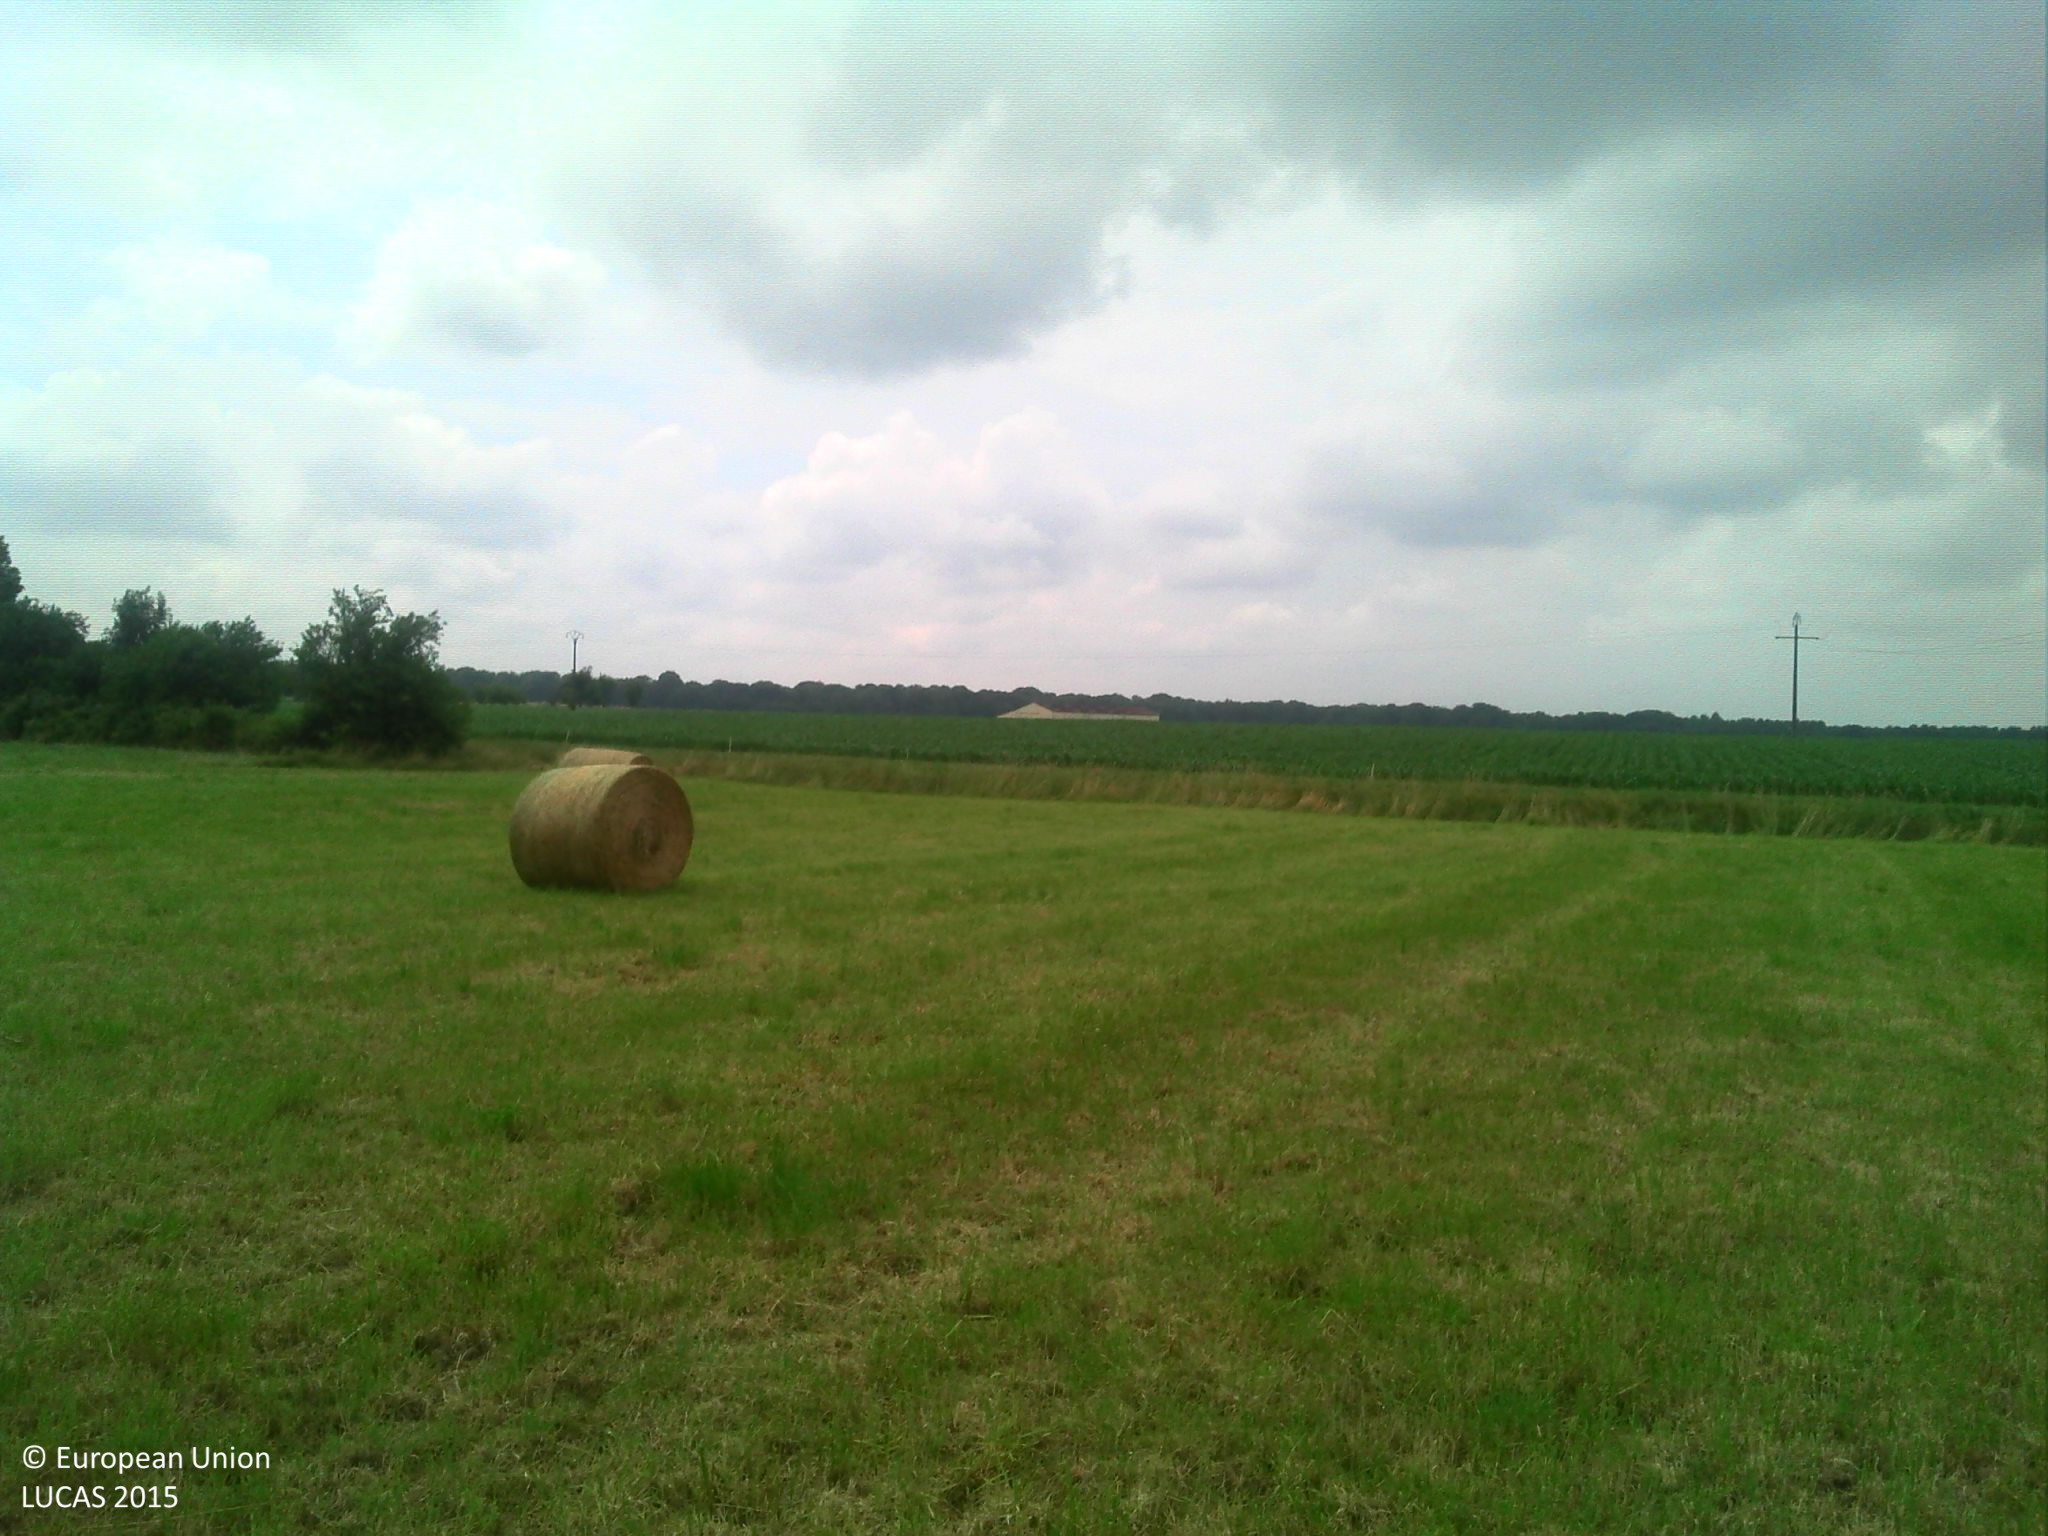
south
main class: Grassland
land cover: Grassland without tree/shrub cover
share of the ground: > 75 %
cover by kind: herbaceous plants 100 %
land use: Agriculture (excluding fallow land and kitchen gardens)
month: June
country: FR
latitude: 47.2281
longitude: 5.4447
